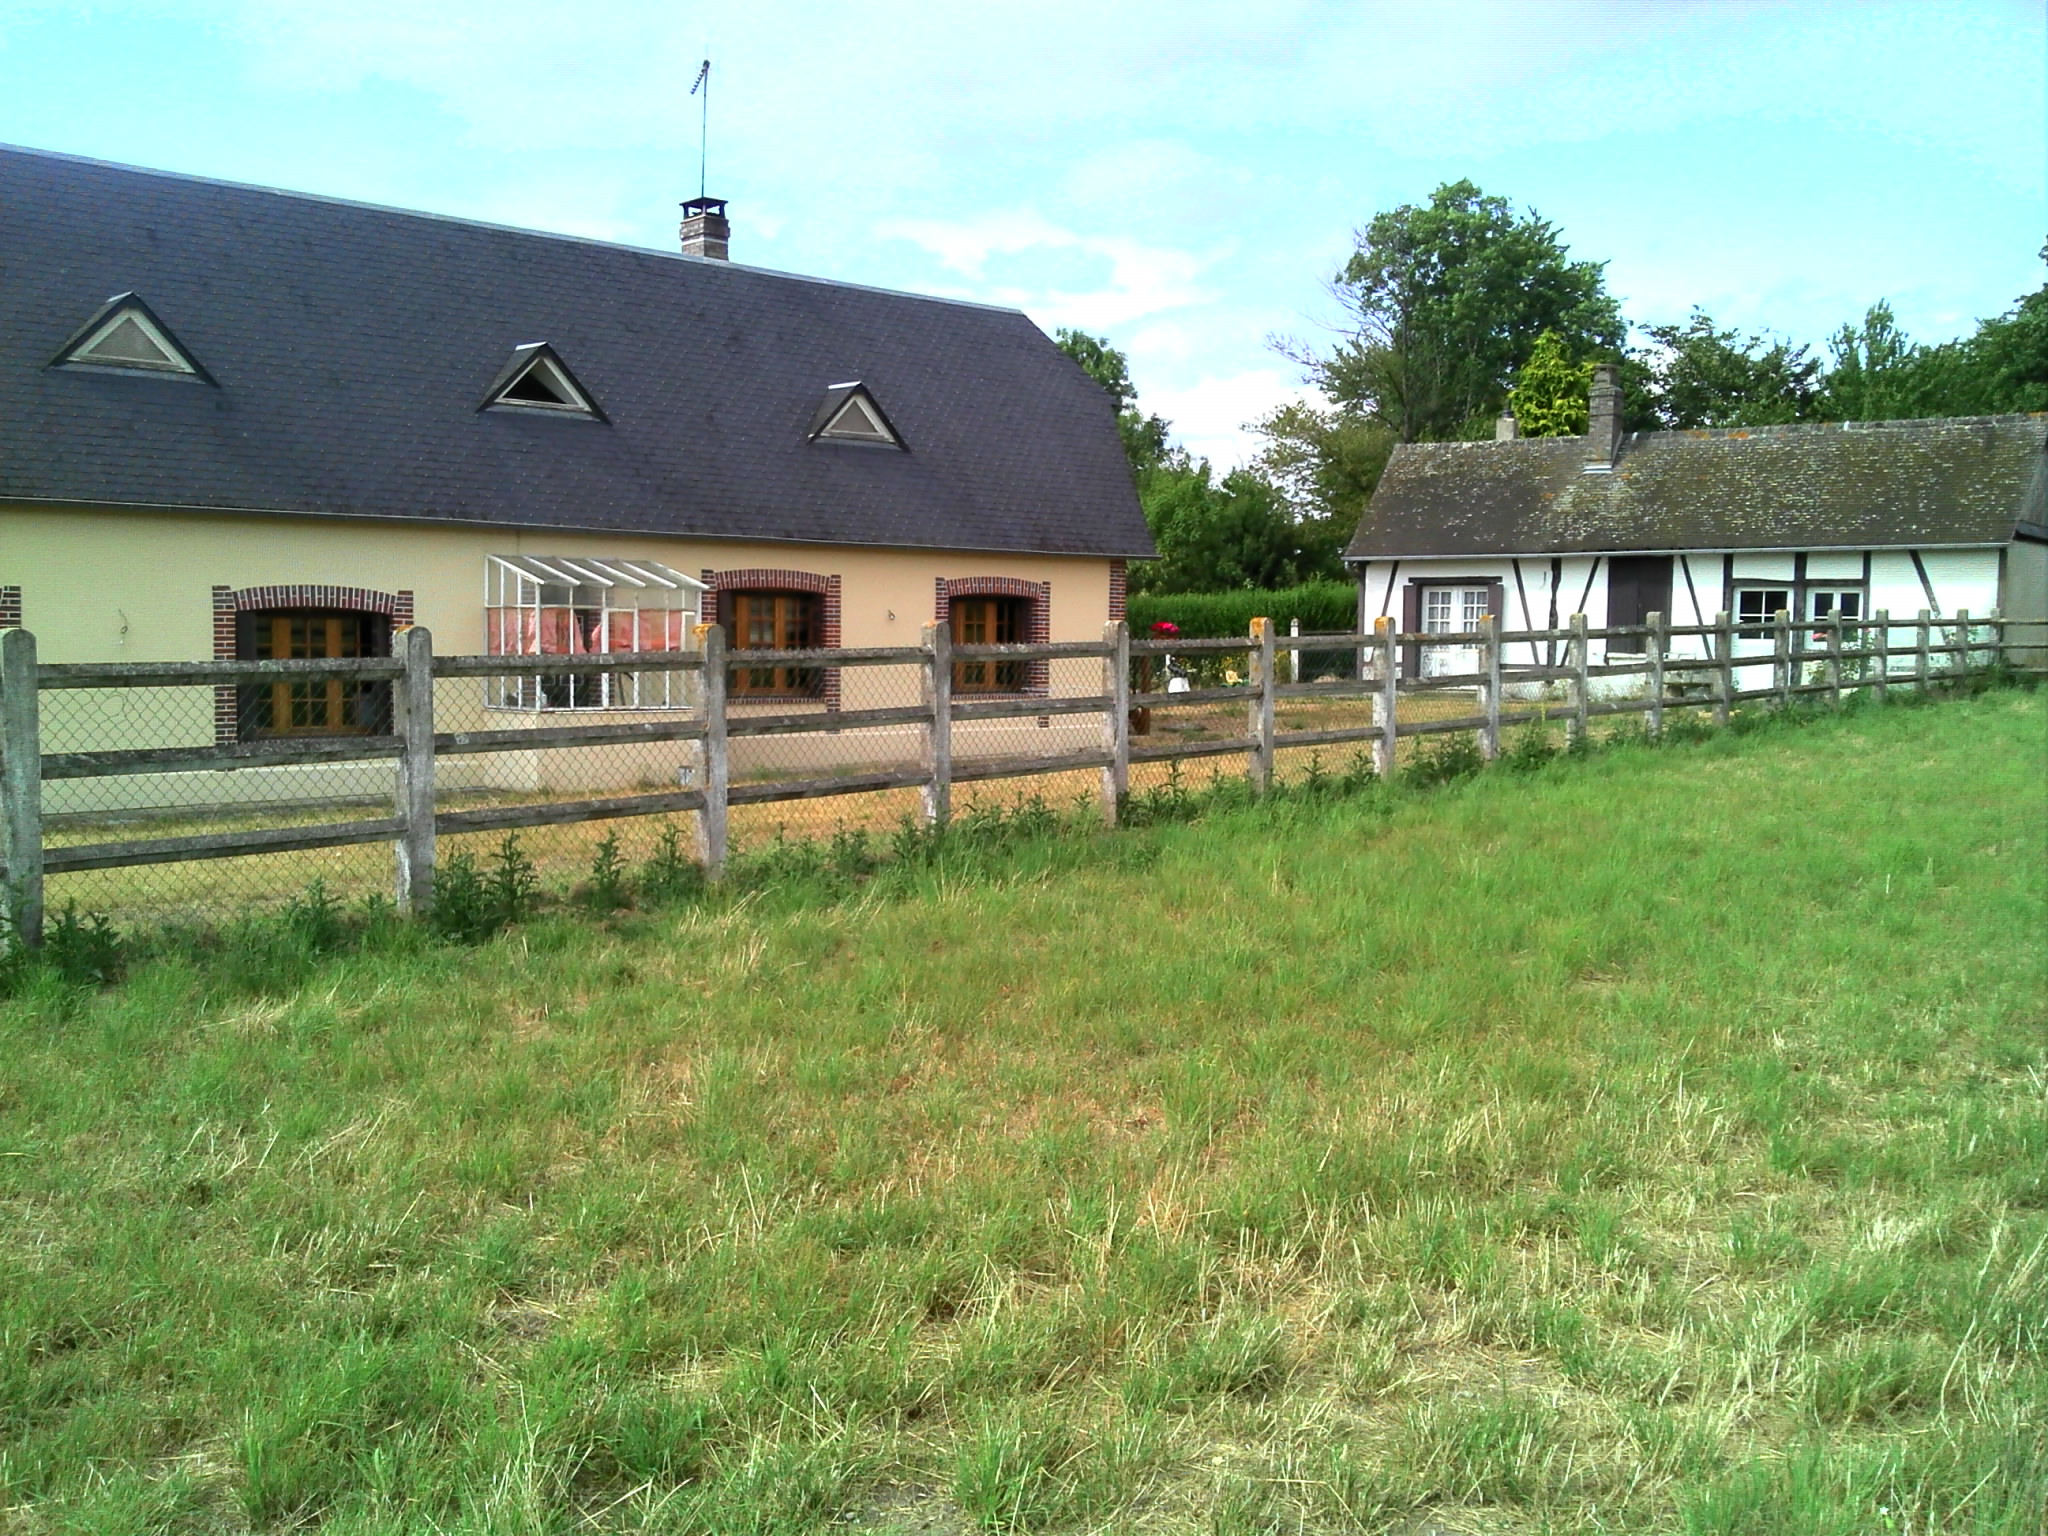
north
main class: Grassland
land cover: Grassland without tree/shrub cover
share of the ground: > 75 %
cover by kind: herbaceous plants 100 %
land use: Agriculture (excluding fallow land and kitchen gardens)
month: July
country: FR
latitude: 48.9325
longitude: 1.1204
